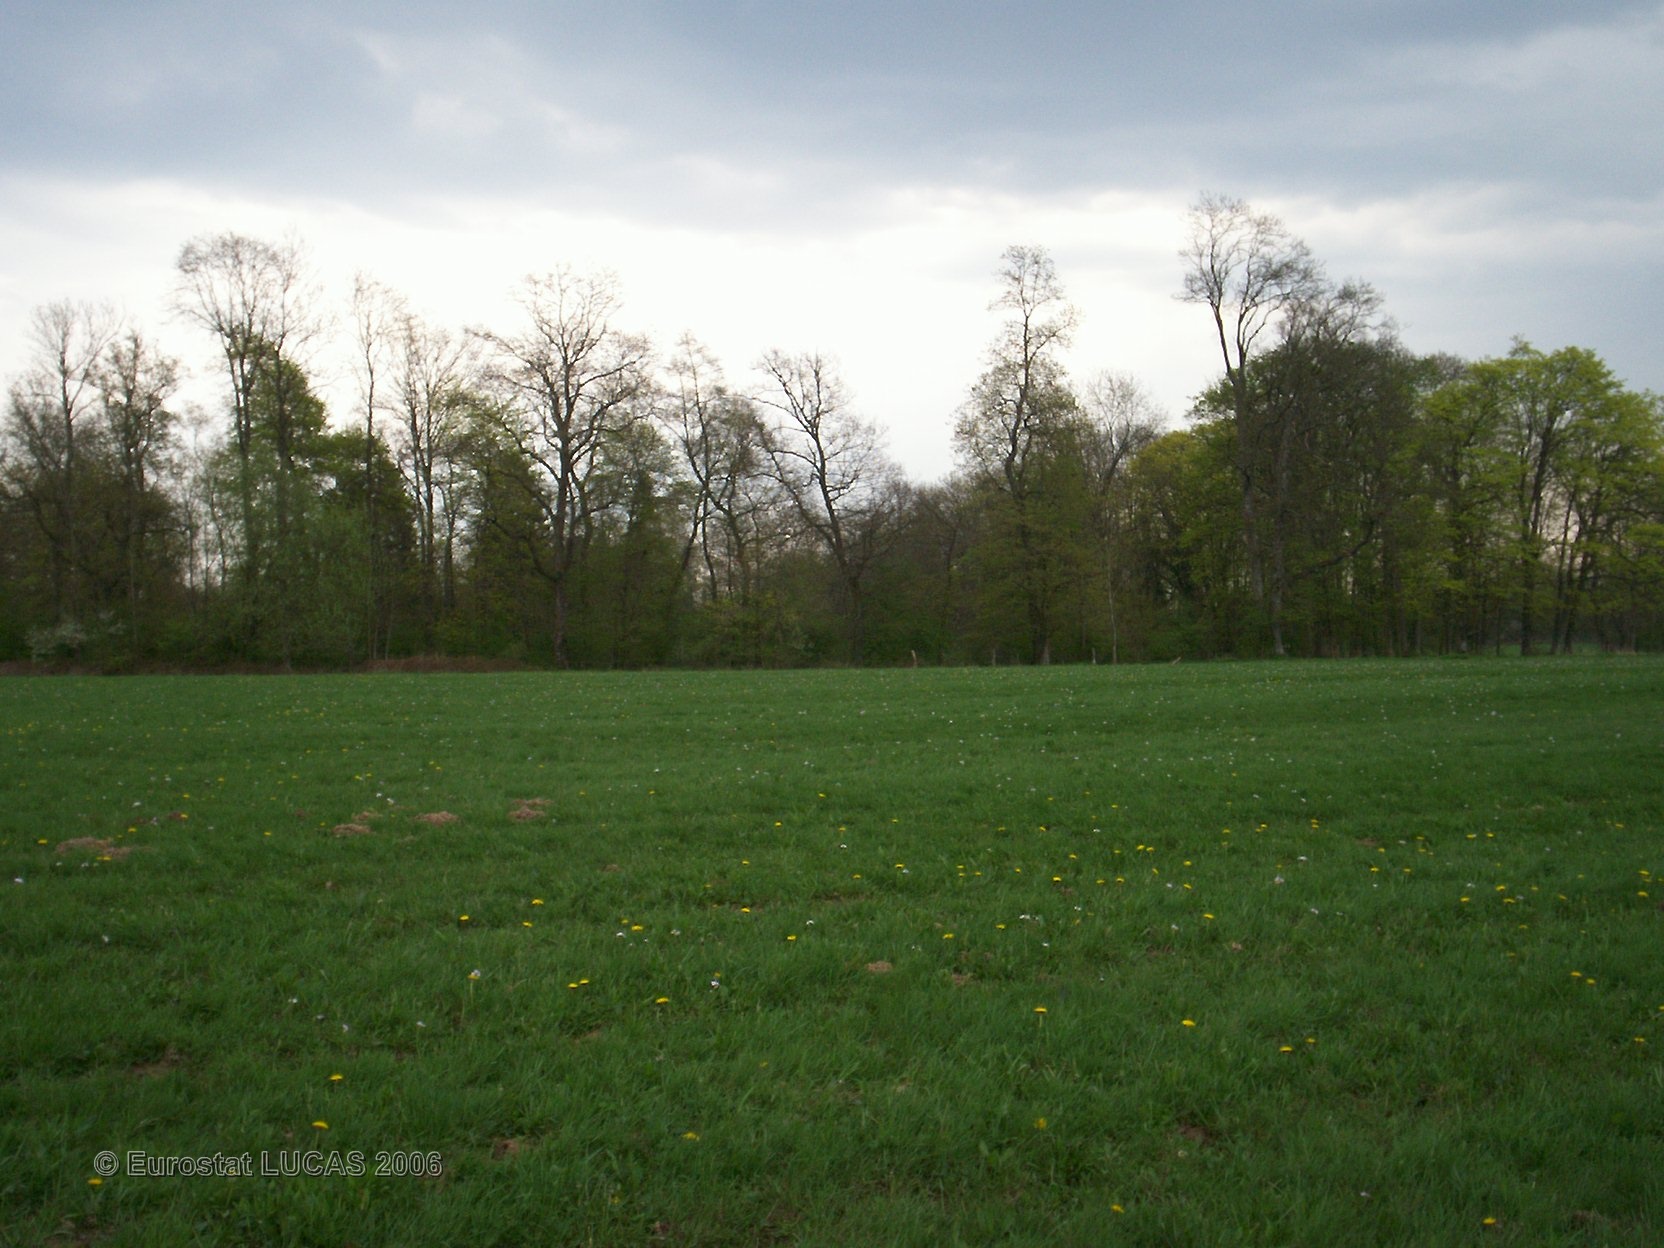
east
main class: Grassland
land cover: Grassland without tree/shrub cover
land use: Agriculture (excluding fallow land and kitchen gardens)
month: May
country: FR
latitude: 49.8961
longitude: 4.2738
